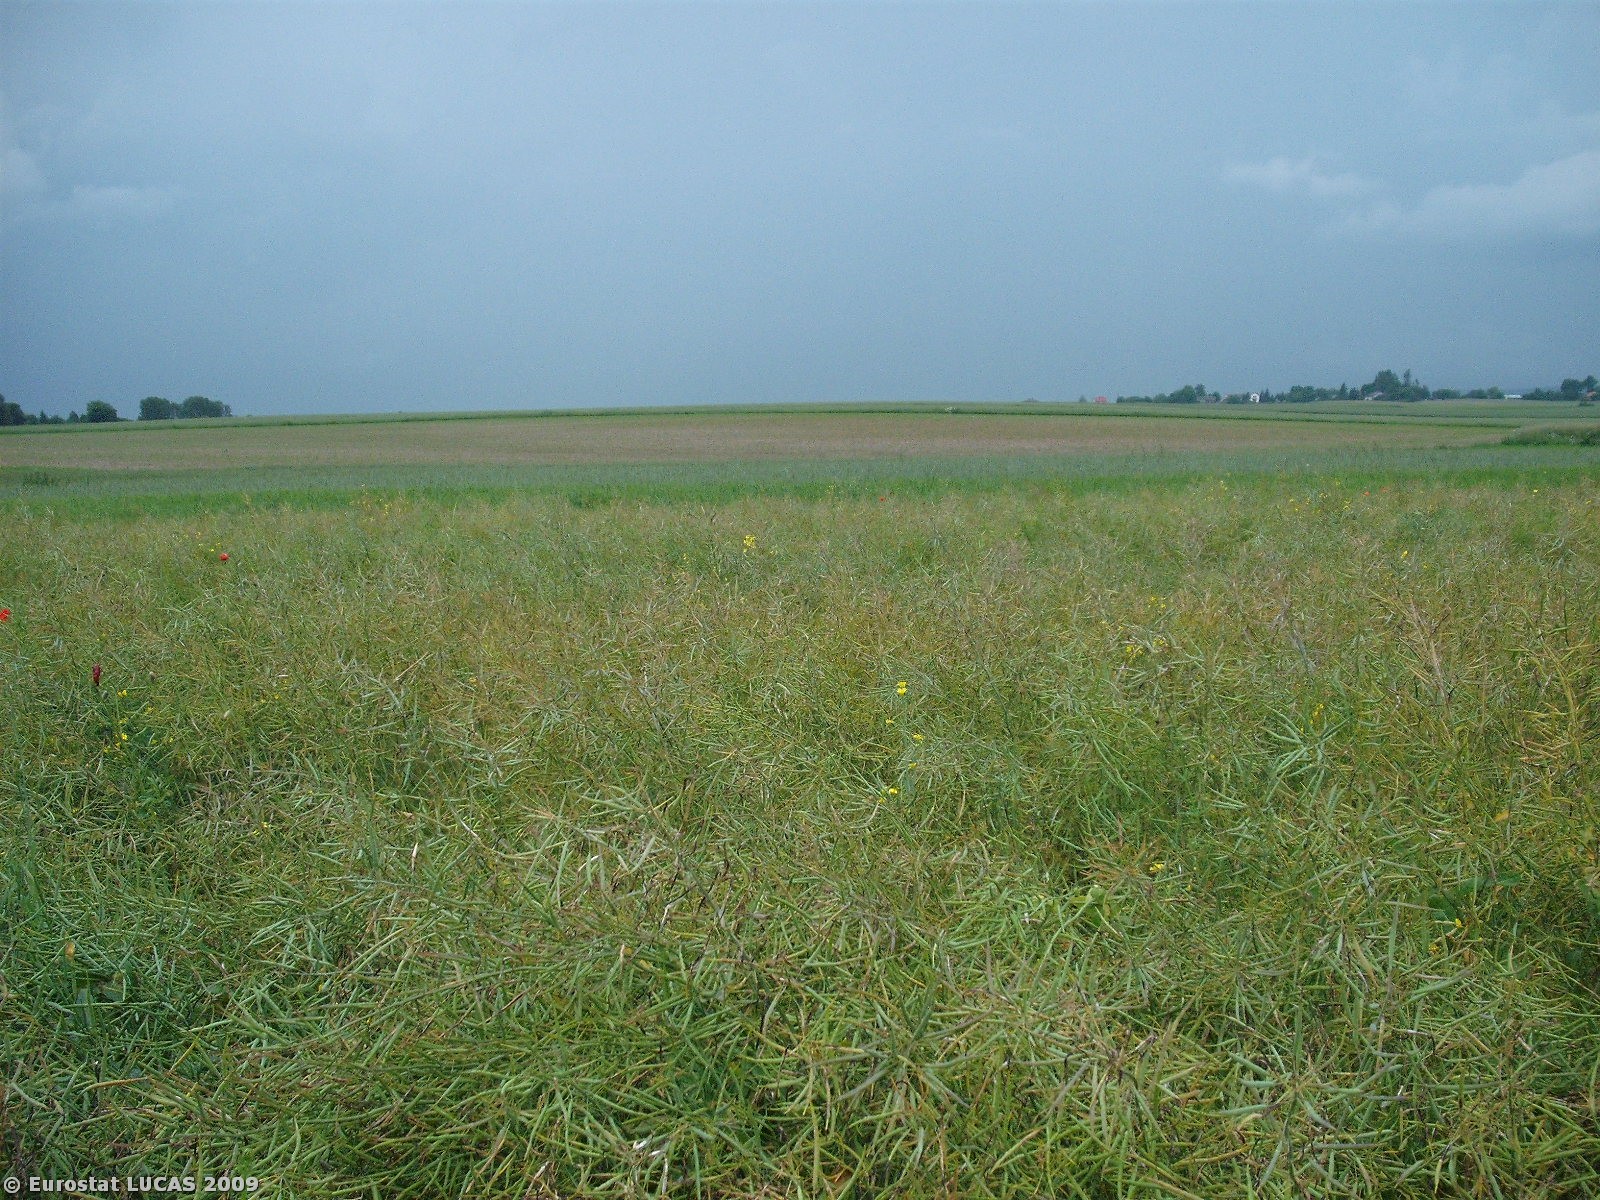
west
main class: Cropland
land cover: Rape and turnip rape
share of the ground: > 75 %
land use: Agriculture (excluding fallow land and kitchen gardens)
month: June
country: PL
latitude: 50.7804
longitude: 21.3237
